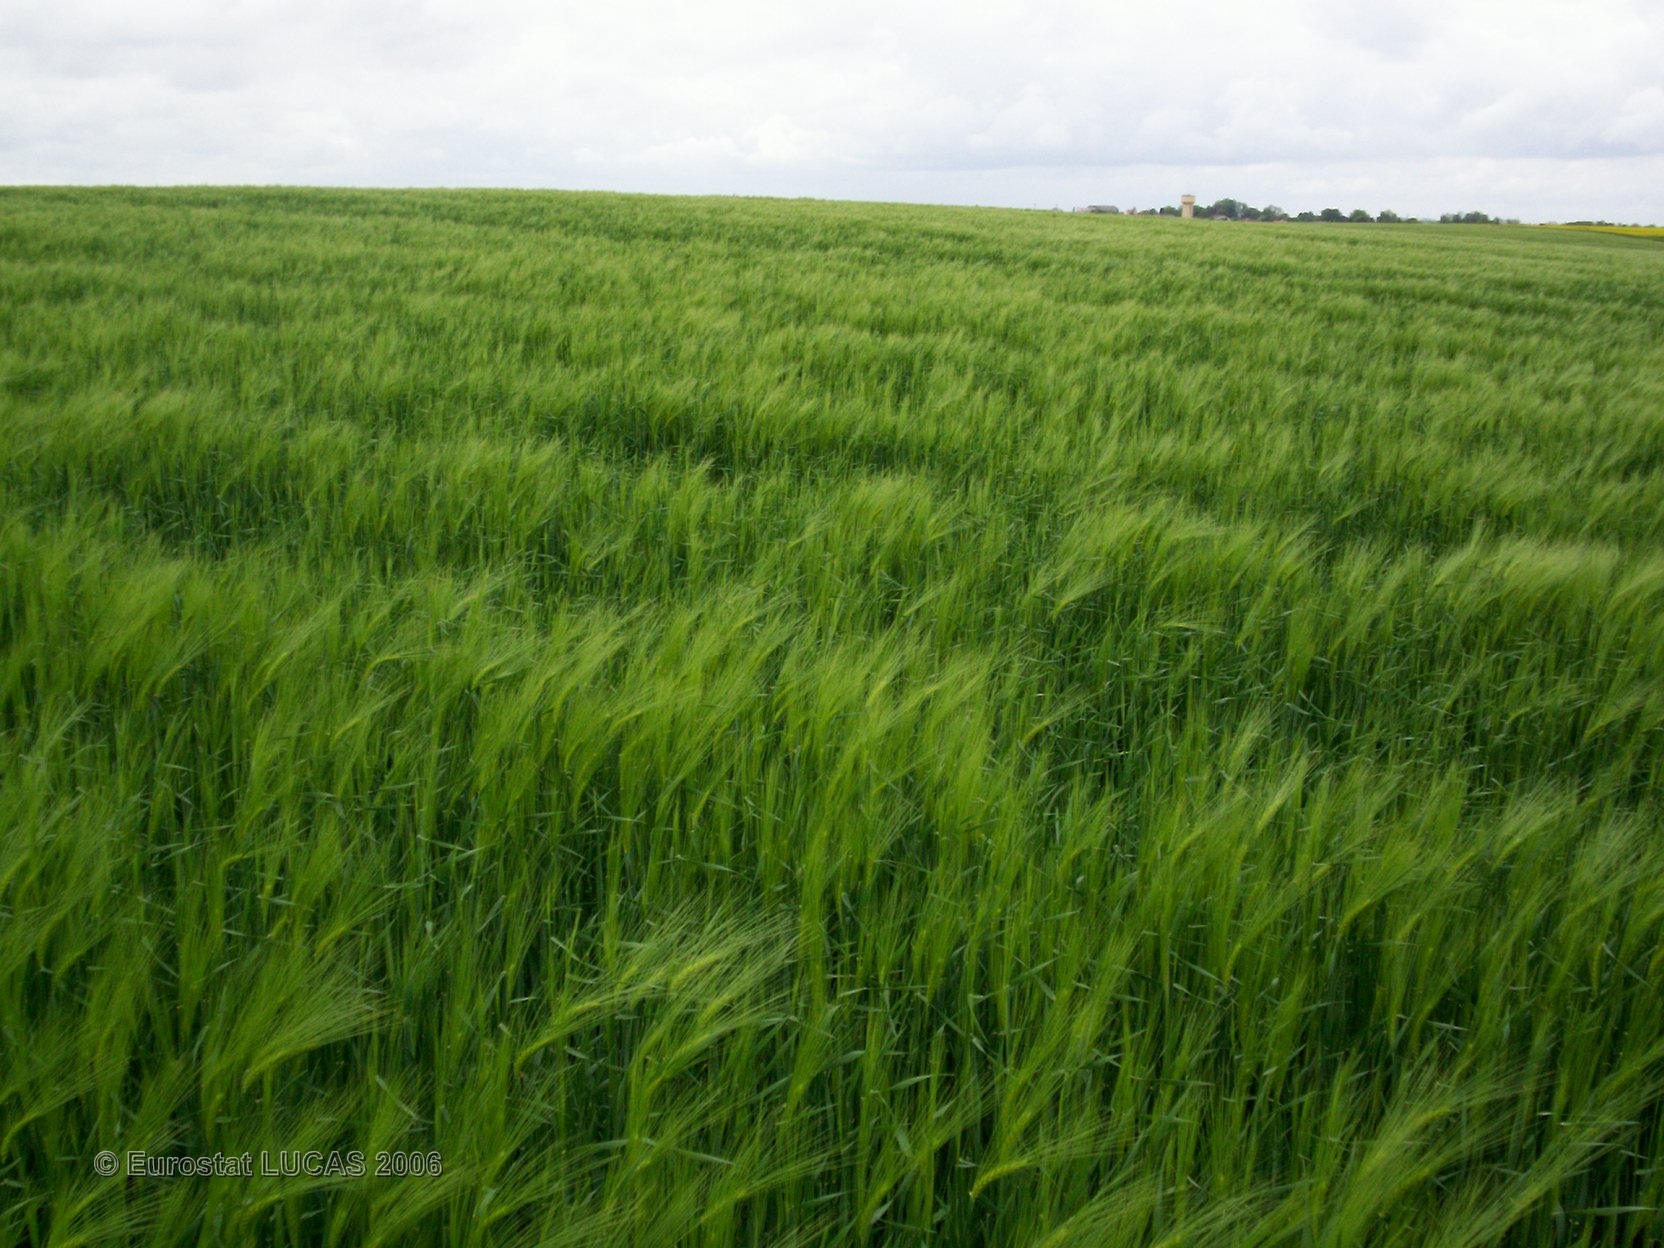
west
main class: Cropland
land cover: Barley
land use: Agriculture (excluding fallow land and kitchen gardens)
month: May
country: FR
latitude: 49.4603
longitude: 5.8463
